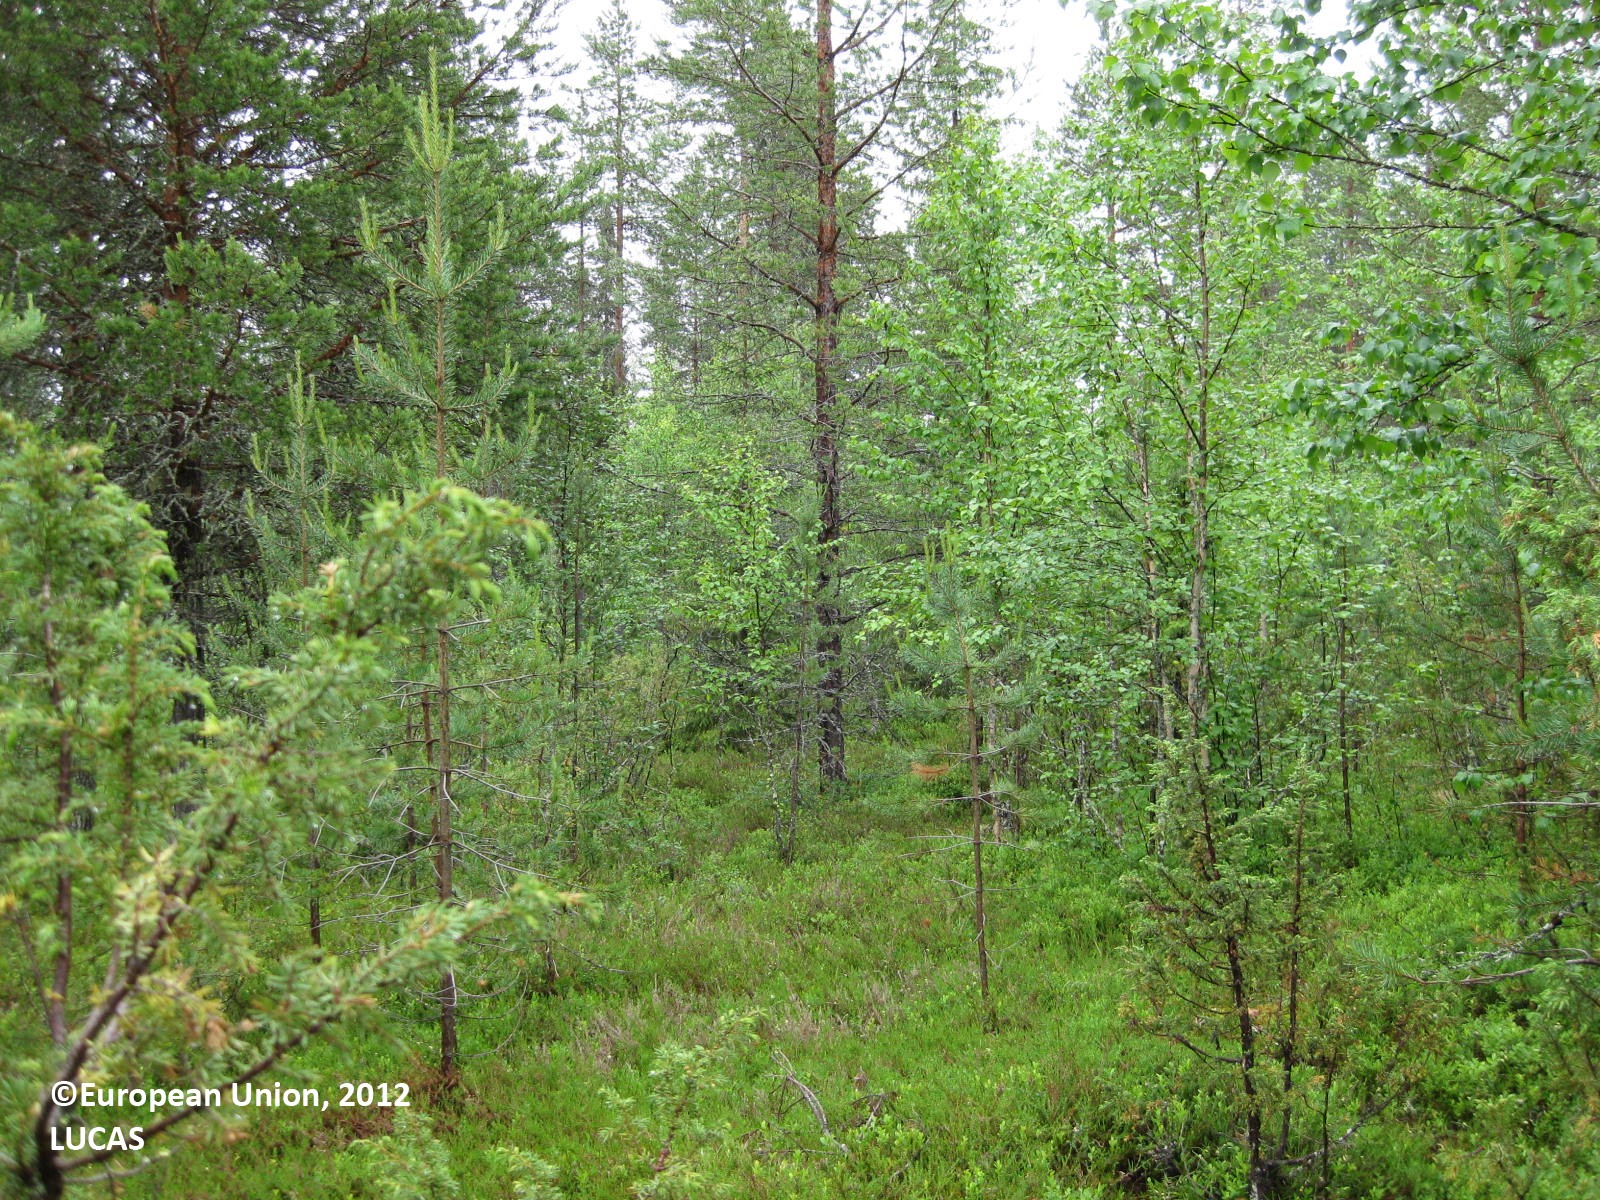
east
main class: Woodland
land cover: Pine dominated mixed woodland
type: boreal forest
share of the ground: > 75 %
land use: Forestry
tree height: > 5 m
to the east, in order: Pine dominated mixed woodland; Other mixed woodland; Shrubland with sparse tree cover; Electric lines; Pine dominated mixed woodland; Pine dominated coniferous woodland
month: July
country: FI
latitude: 65.4577
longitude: 28.2118
